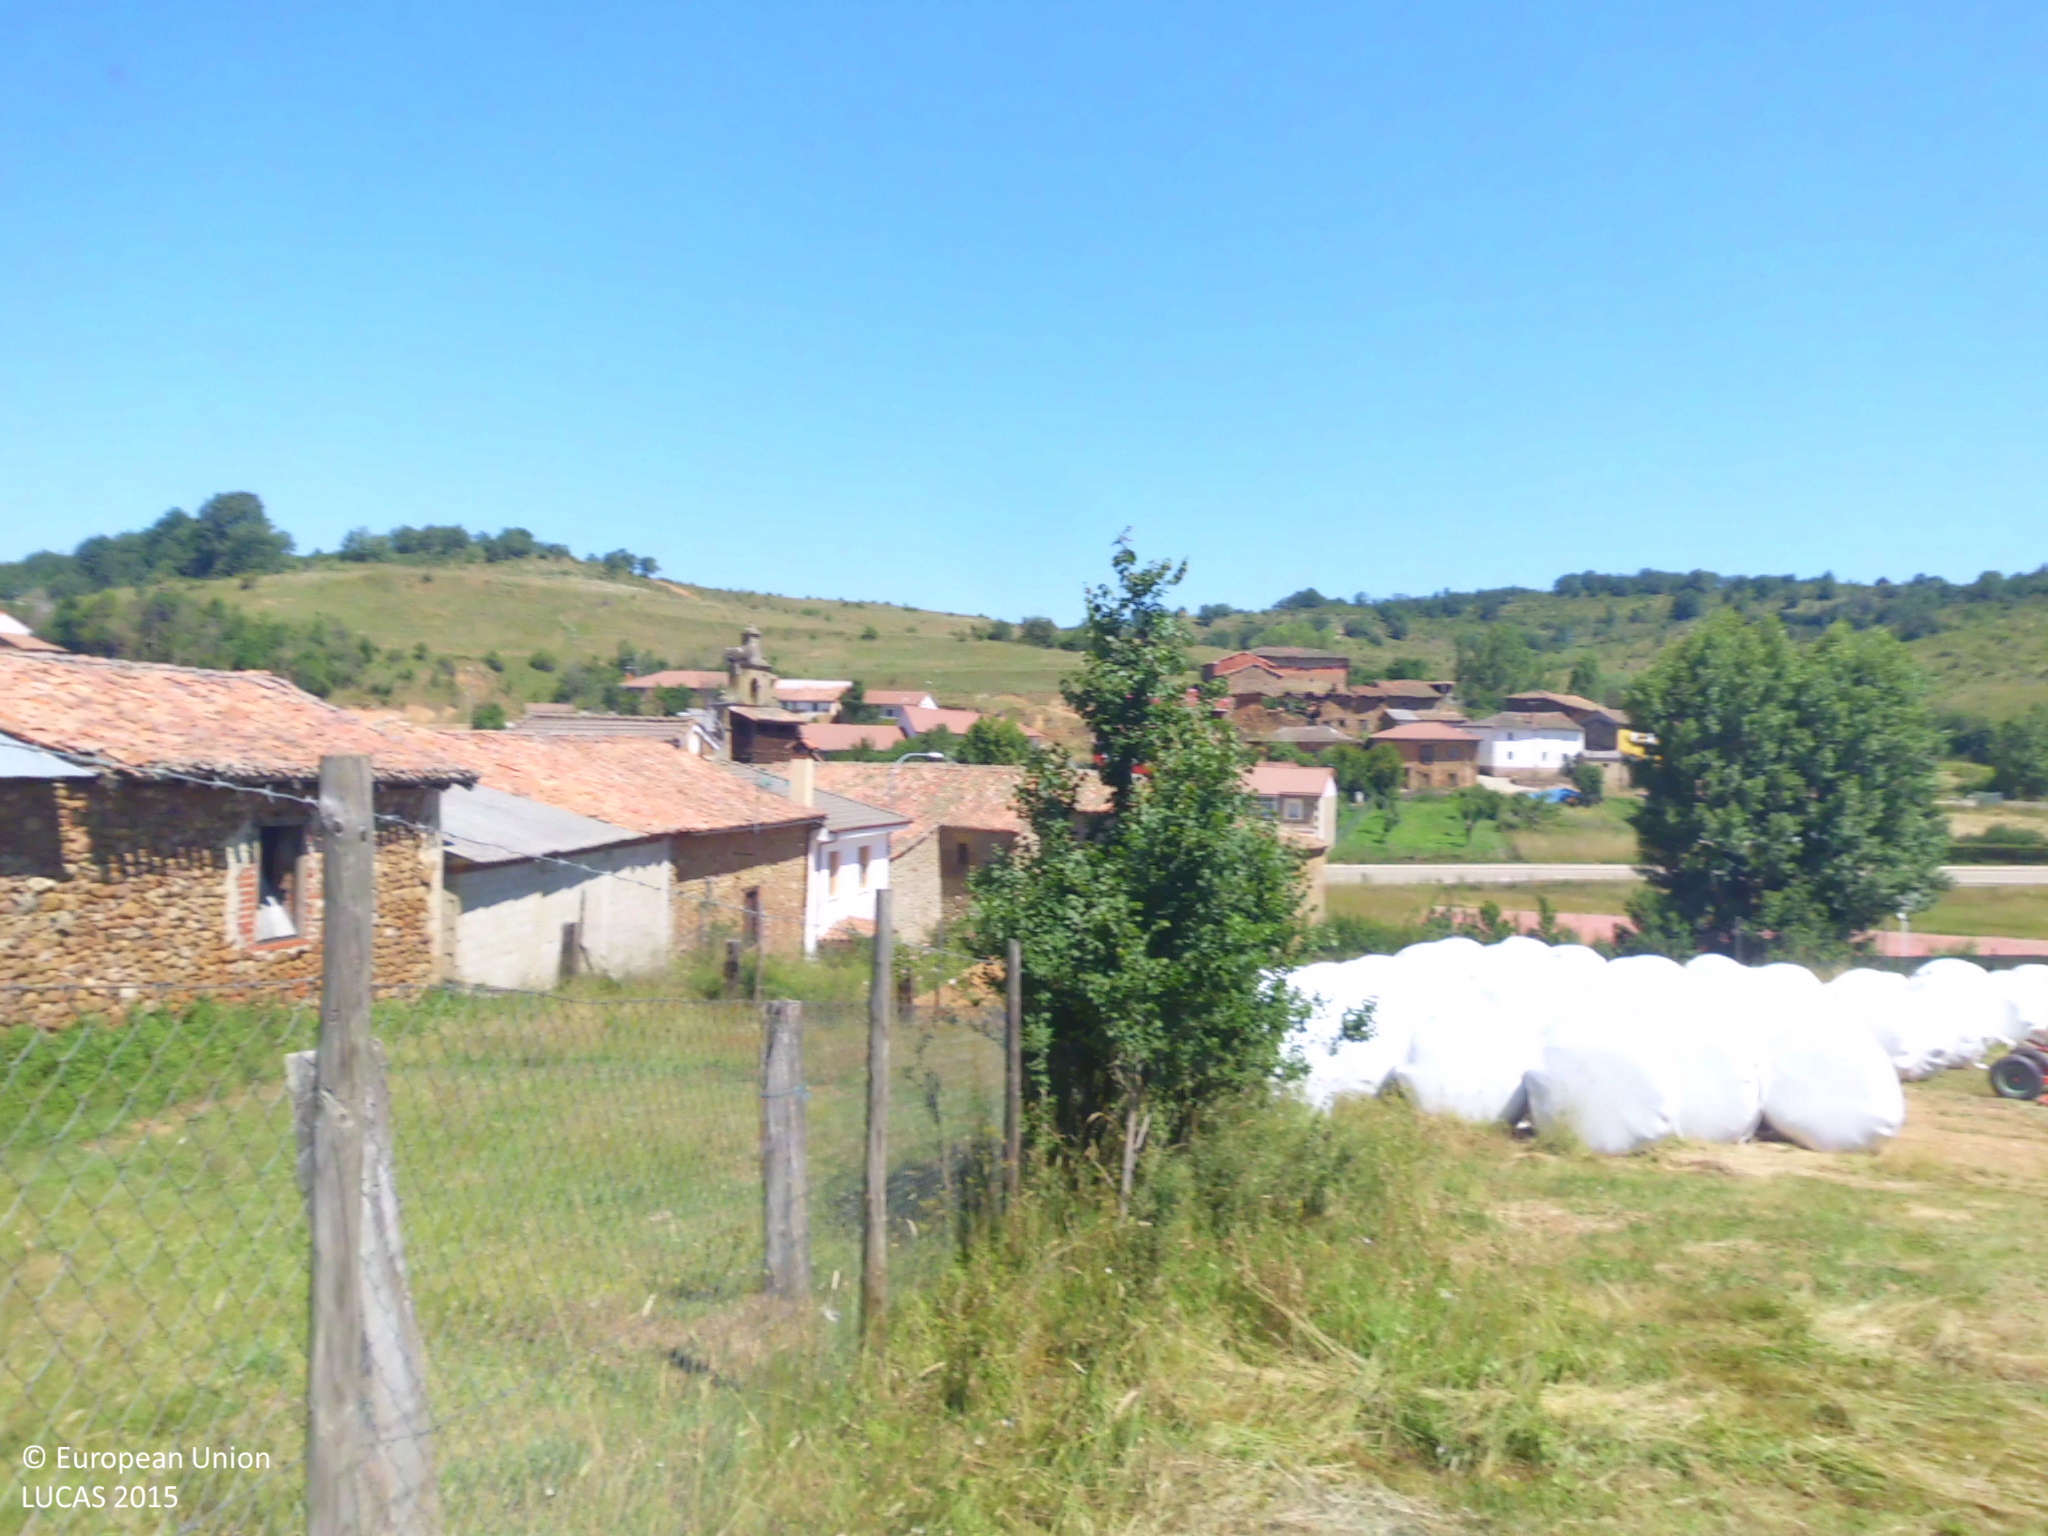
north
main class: Grassland
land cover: Grassland with sparse tree/shrub cover
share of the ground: > 75 %
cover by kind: herbaceous plants 80 %, unconsolidated bare surface 15 %, broadleaved forest trees 5 %
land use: Agriculture (excluding fallow land and kitchen gardens)
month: June
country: ES
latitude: 42.7855
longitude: -4.9393
